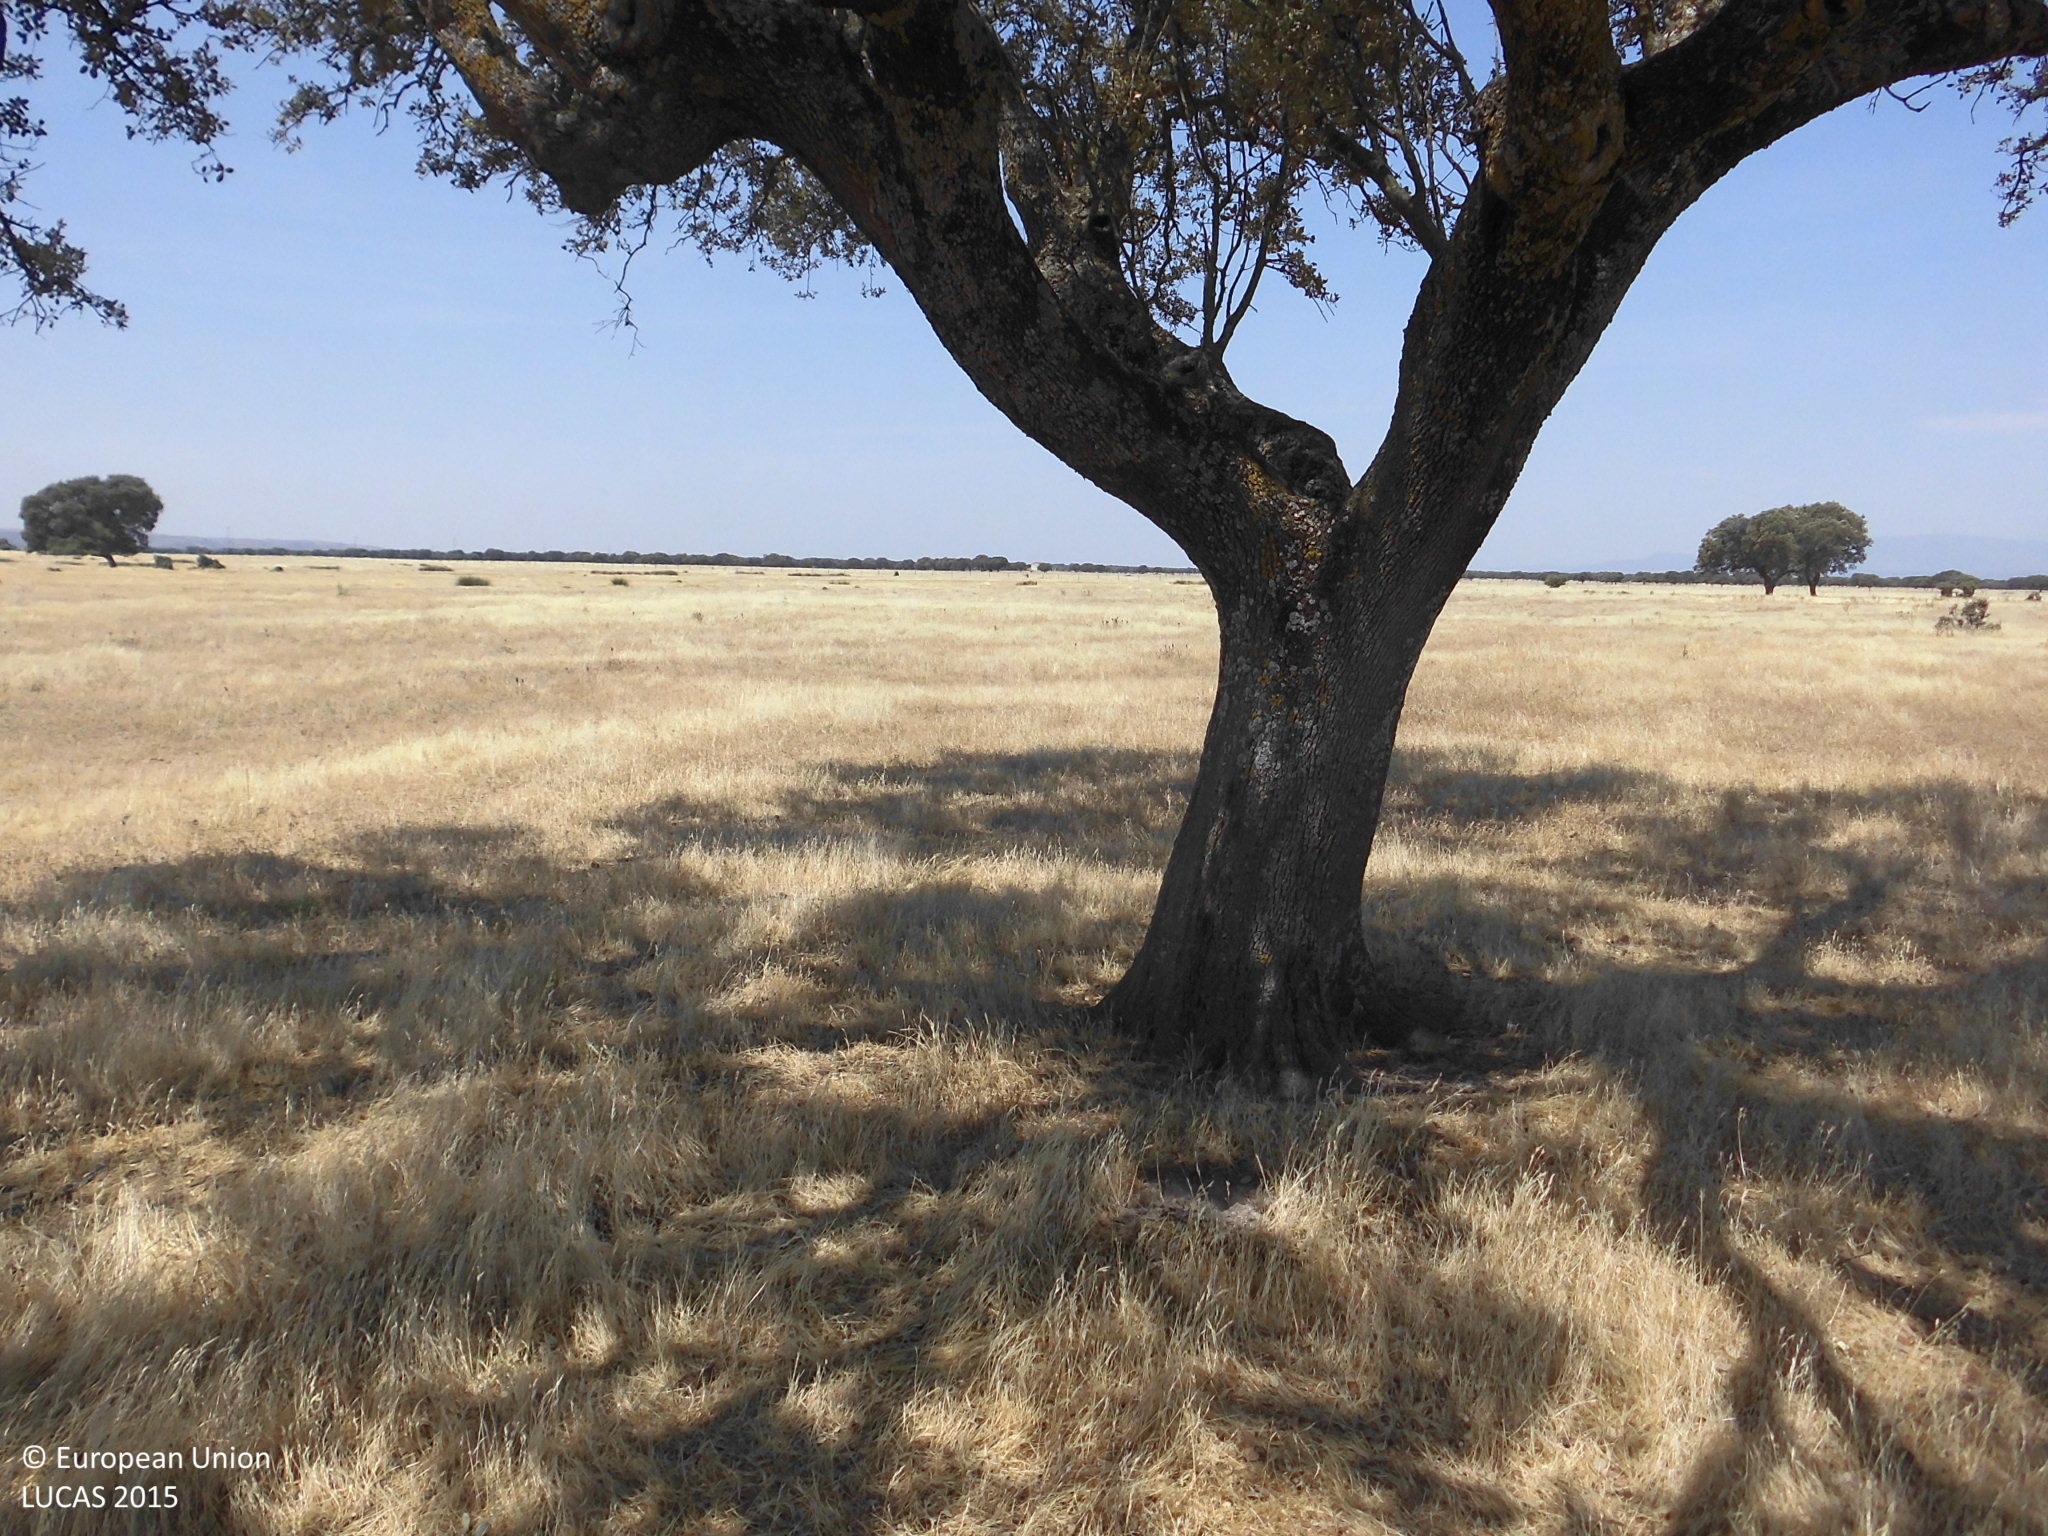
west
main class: Woodland
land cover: Broadleaved woodland
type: broadleaved evergreen forest
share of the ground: 10 - 25 %
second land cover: Grassland without tree/shrub cover
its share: > 75 %
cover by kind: herbaceous plants 90 %, broadleaved forest trees 10 %
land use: Forestry
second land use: Agriculture (excluding fallow land and kitchen gardens)
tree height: > 5 m
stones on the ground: < 10 %
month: June
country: ES
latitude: 39.9437
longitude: -5.4007
